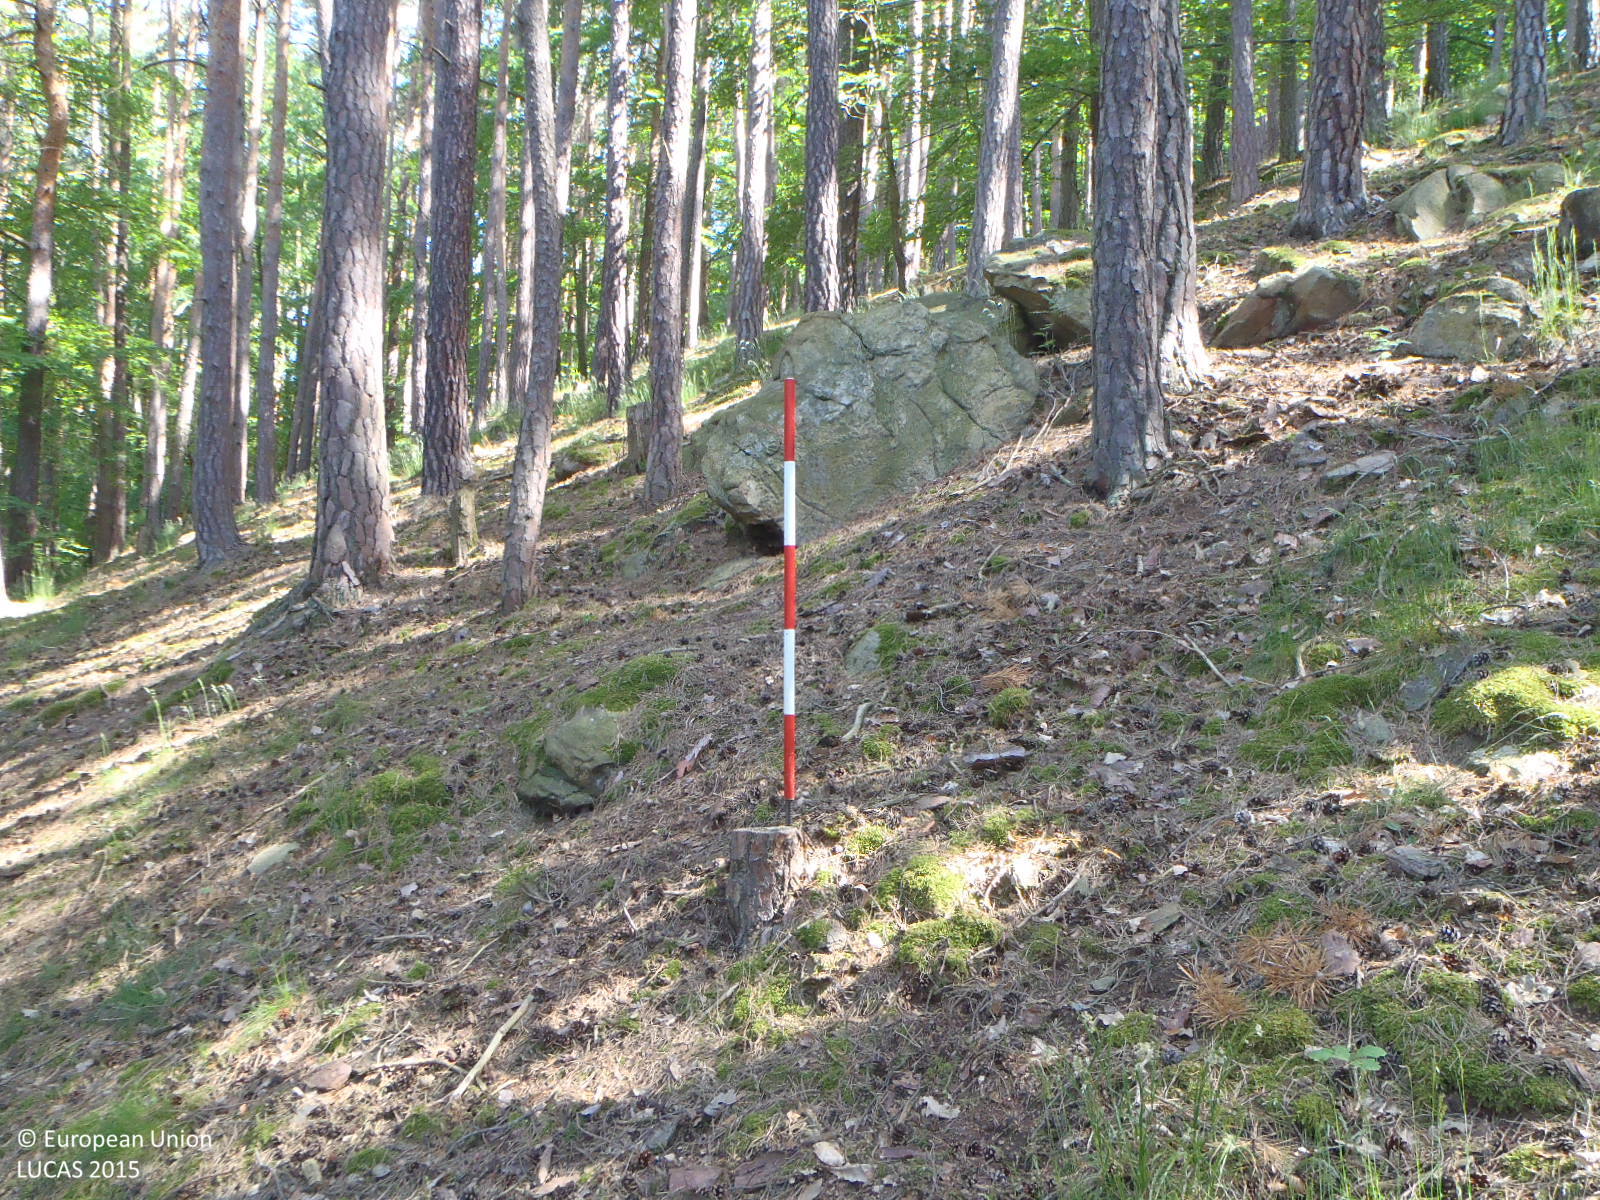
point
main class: Woodland
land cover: Pine dominated coniferous woodland
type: hemiboreal forest and nemoral coniferous forest and mixed broadleaved-coniferous forest
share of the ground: > 75 %
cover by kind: coniferous forest trees 90 %, broadleaved forest trees 5 %, herbaceous plants 5 %
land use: Forestry
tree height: > 5 m
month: June
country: CZ
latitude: 48.8574
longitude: 14.3760
